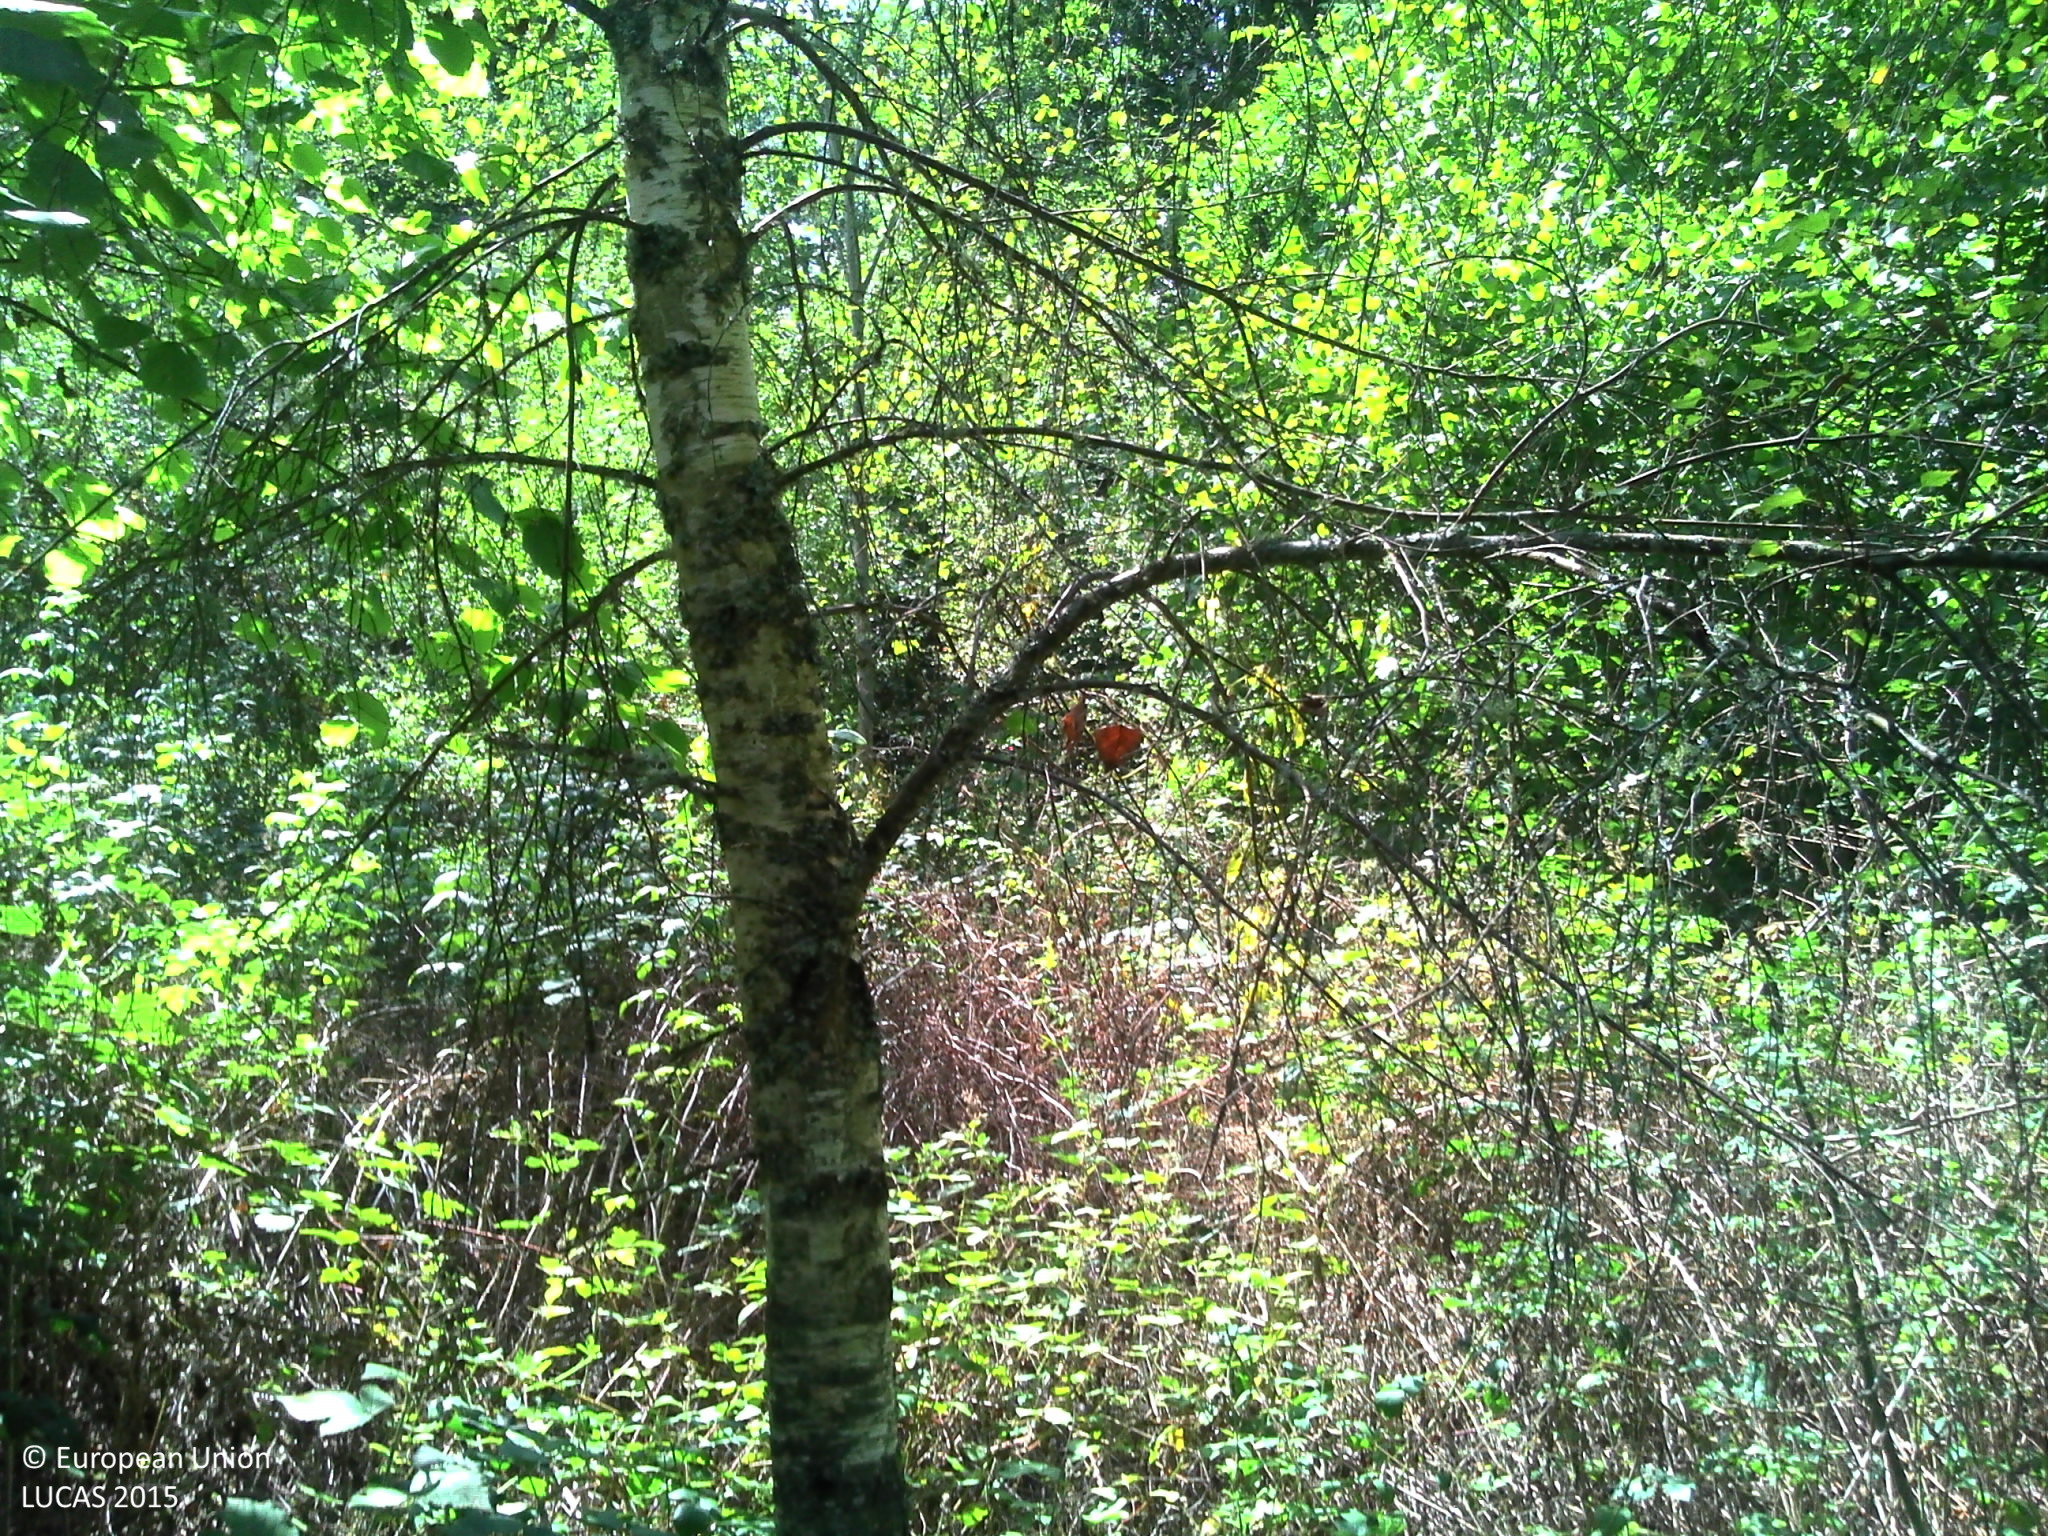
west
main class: Woodland
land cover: Spruce dominated mixed woodland
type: mesophytic deciduous forest
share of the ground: > 75 %
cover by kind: broadleaved forest trees 60 %, coniferous forest trees 25 %, shrubs 10 %, herbaceous plants 5 %
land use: Semi-natural and natural areas not in use
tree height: > 5 m
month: August
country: FR
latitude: 45.7889
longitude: 2.3688
